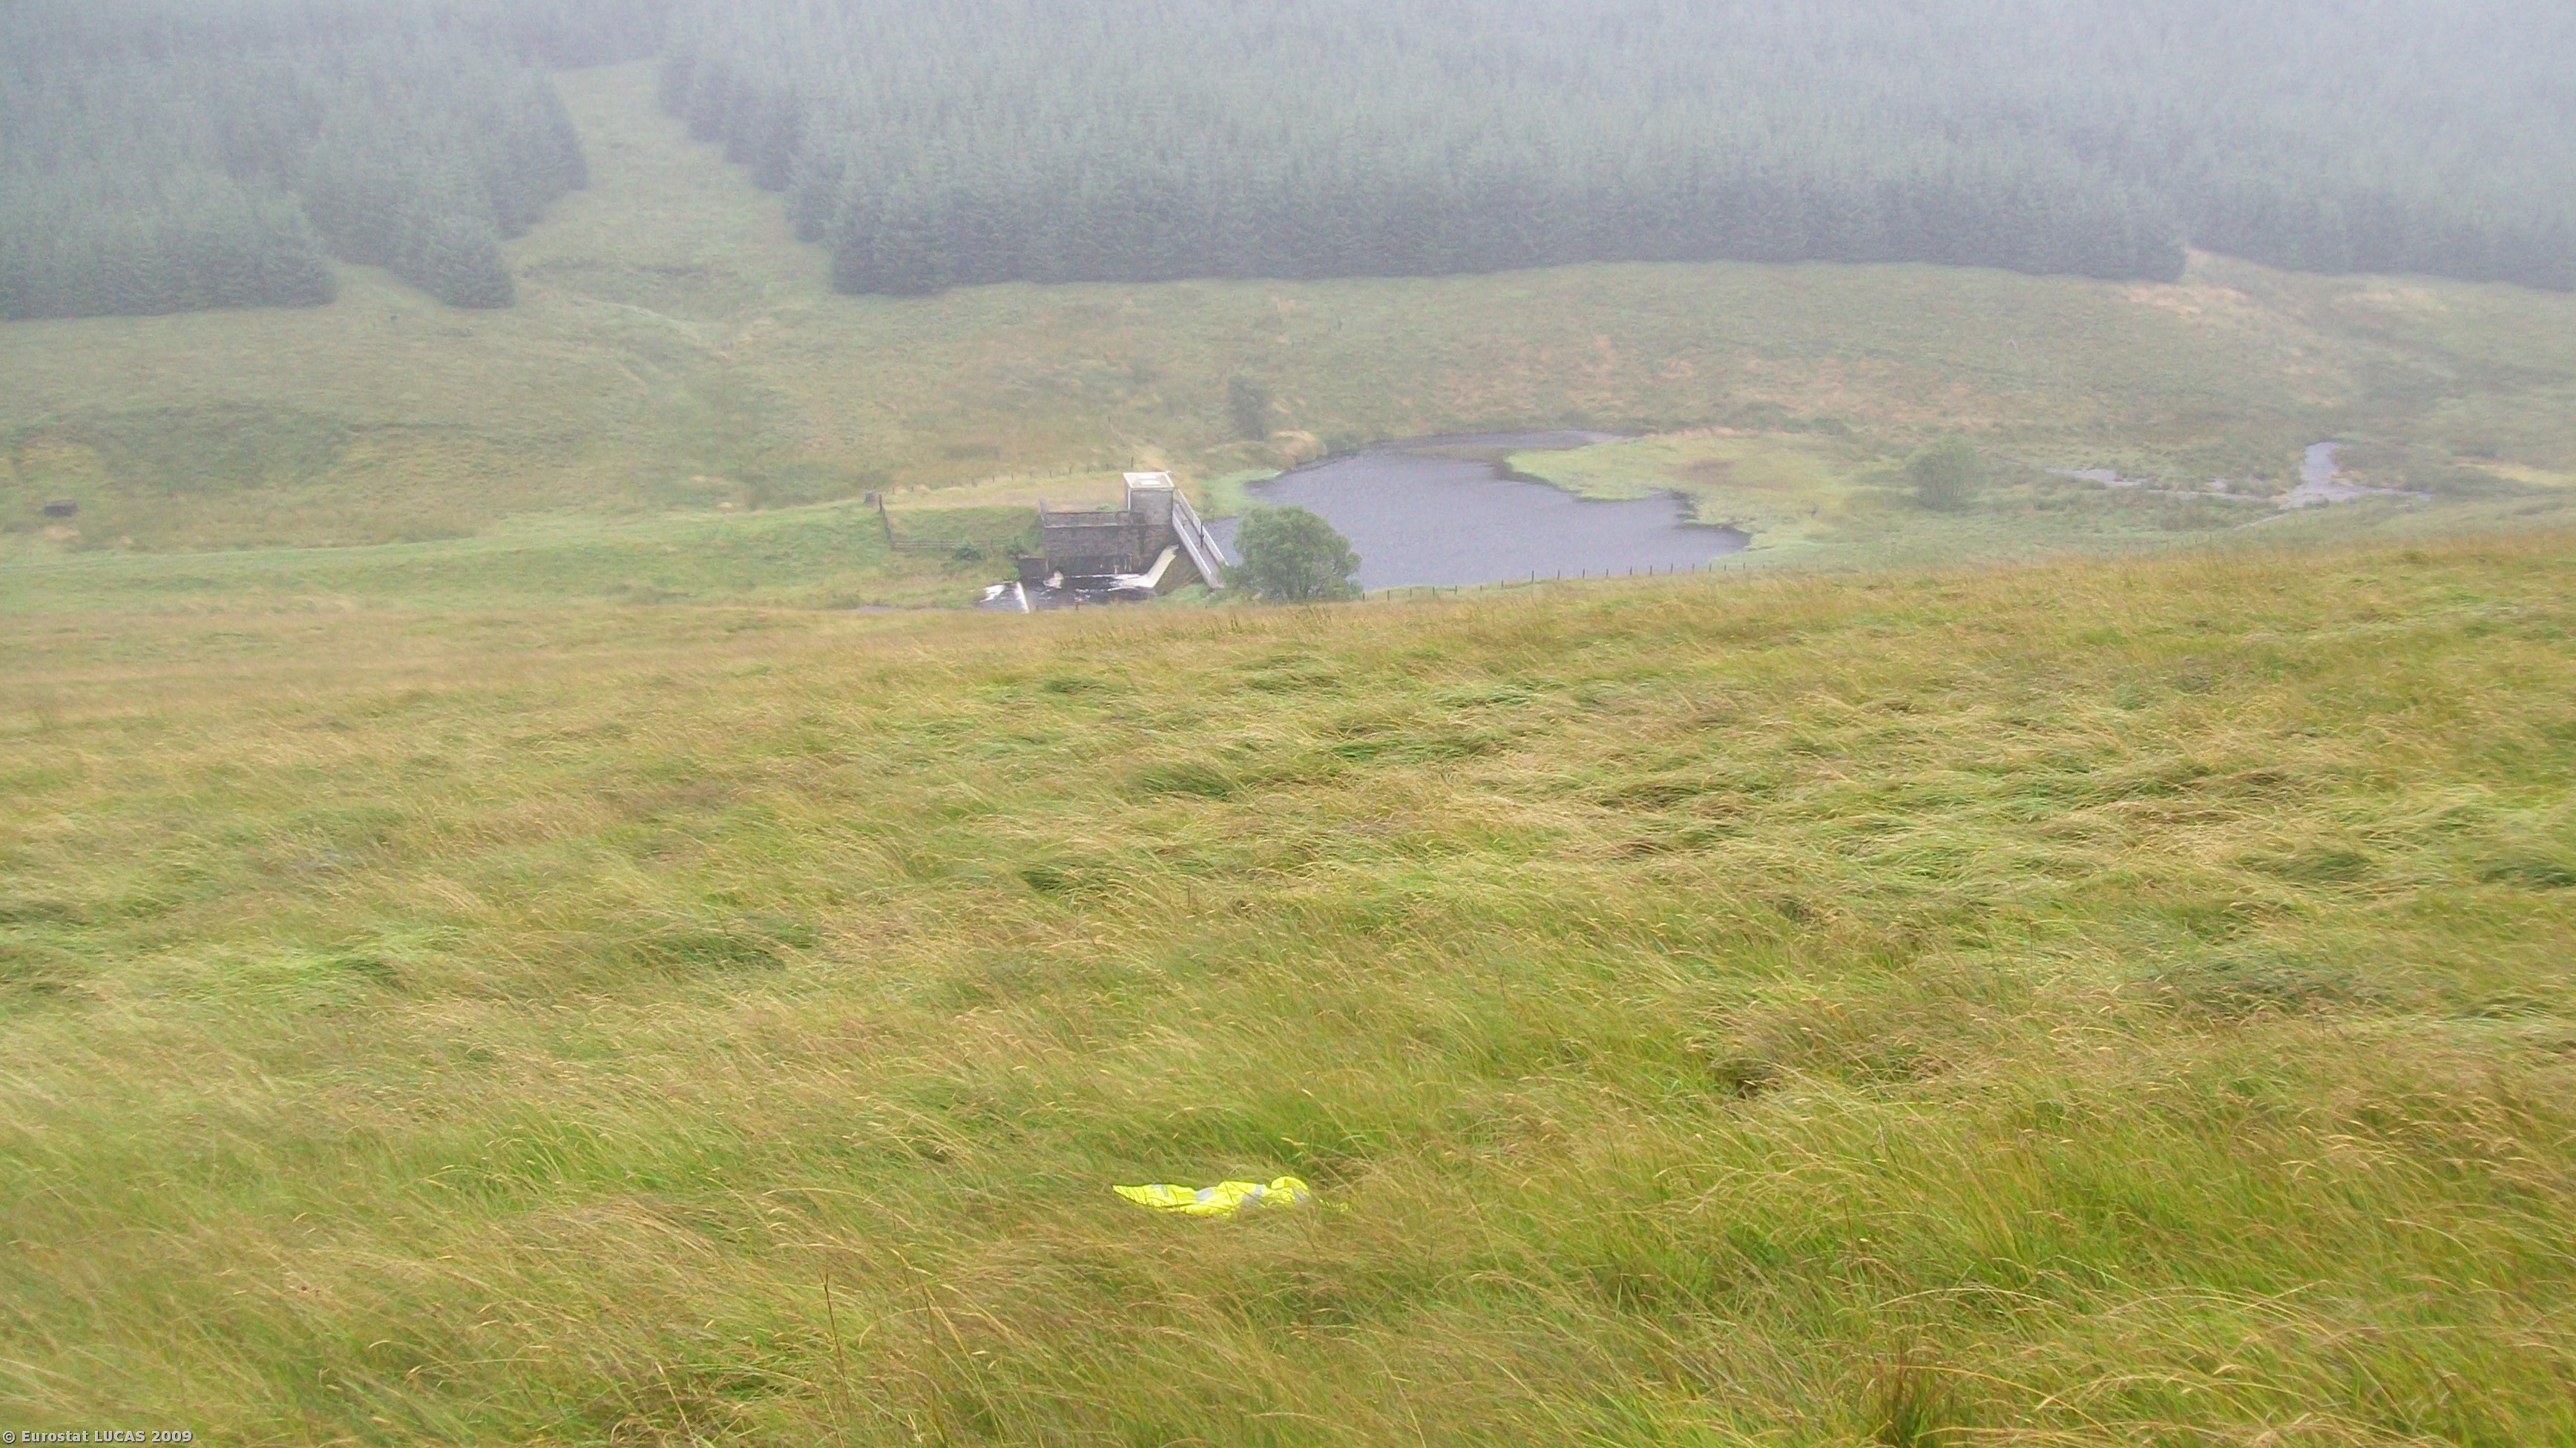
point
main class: Grassland
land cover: Grassland without tree/shrub cover
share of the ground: > 75 %
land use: Agriculture (excluding fallow land and kitchen gardens)
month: August
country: GB
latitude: 55.4723
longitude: -3.4779
